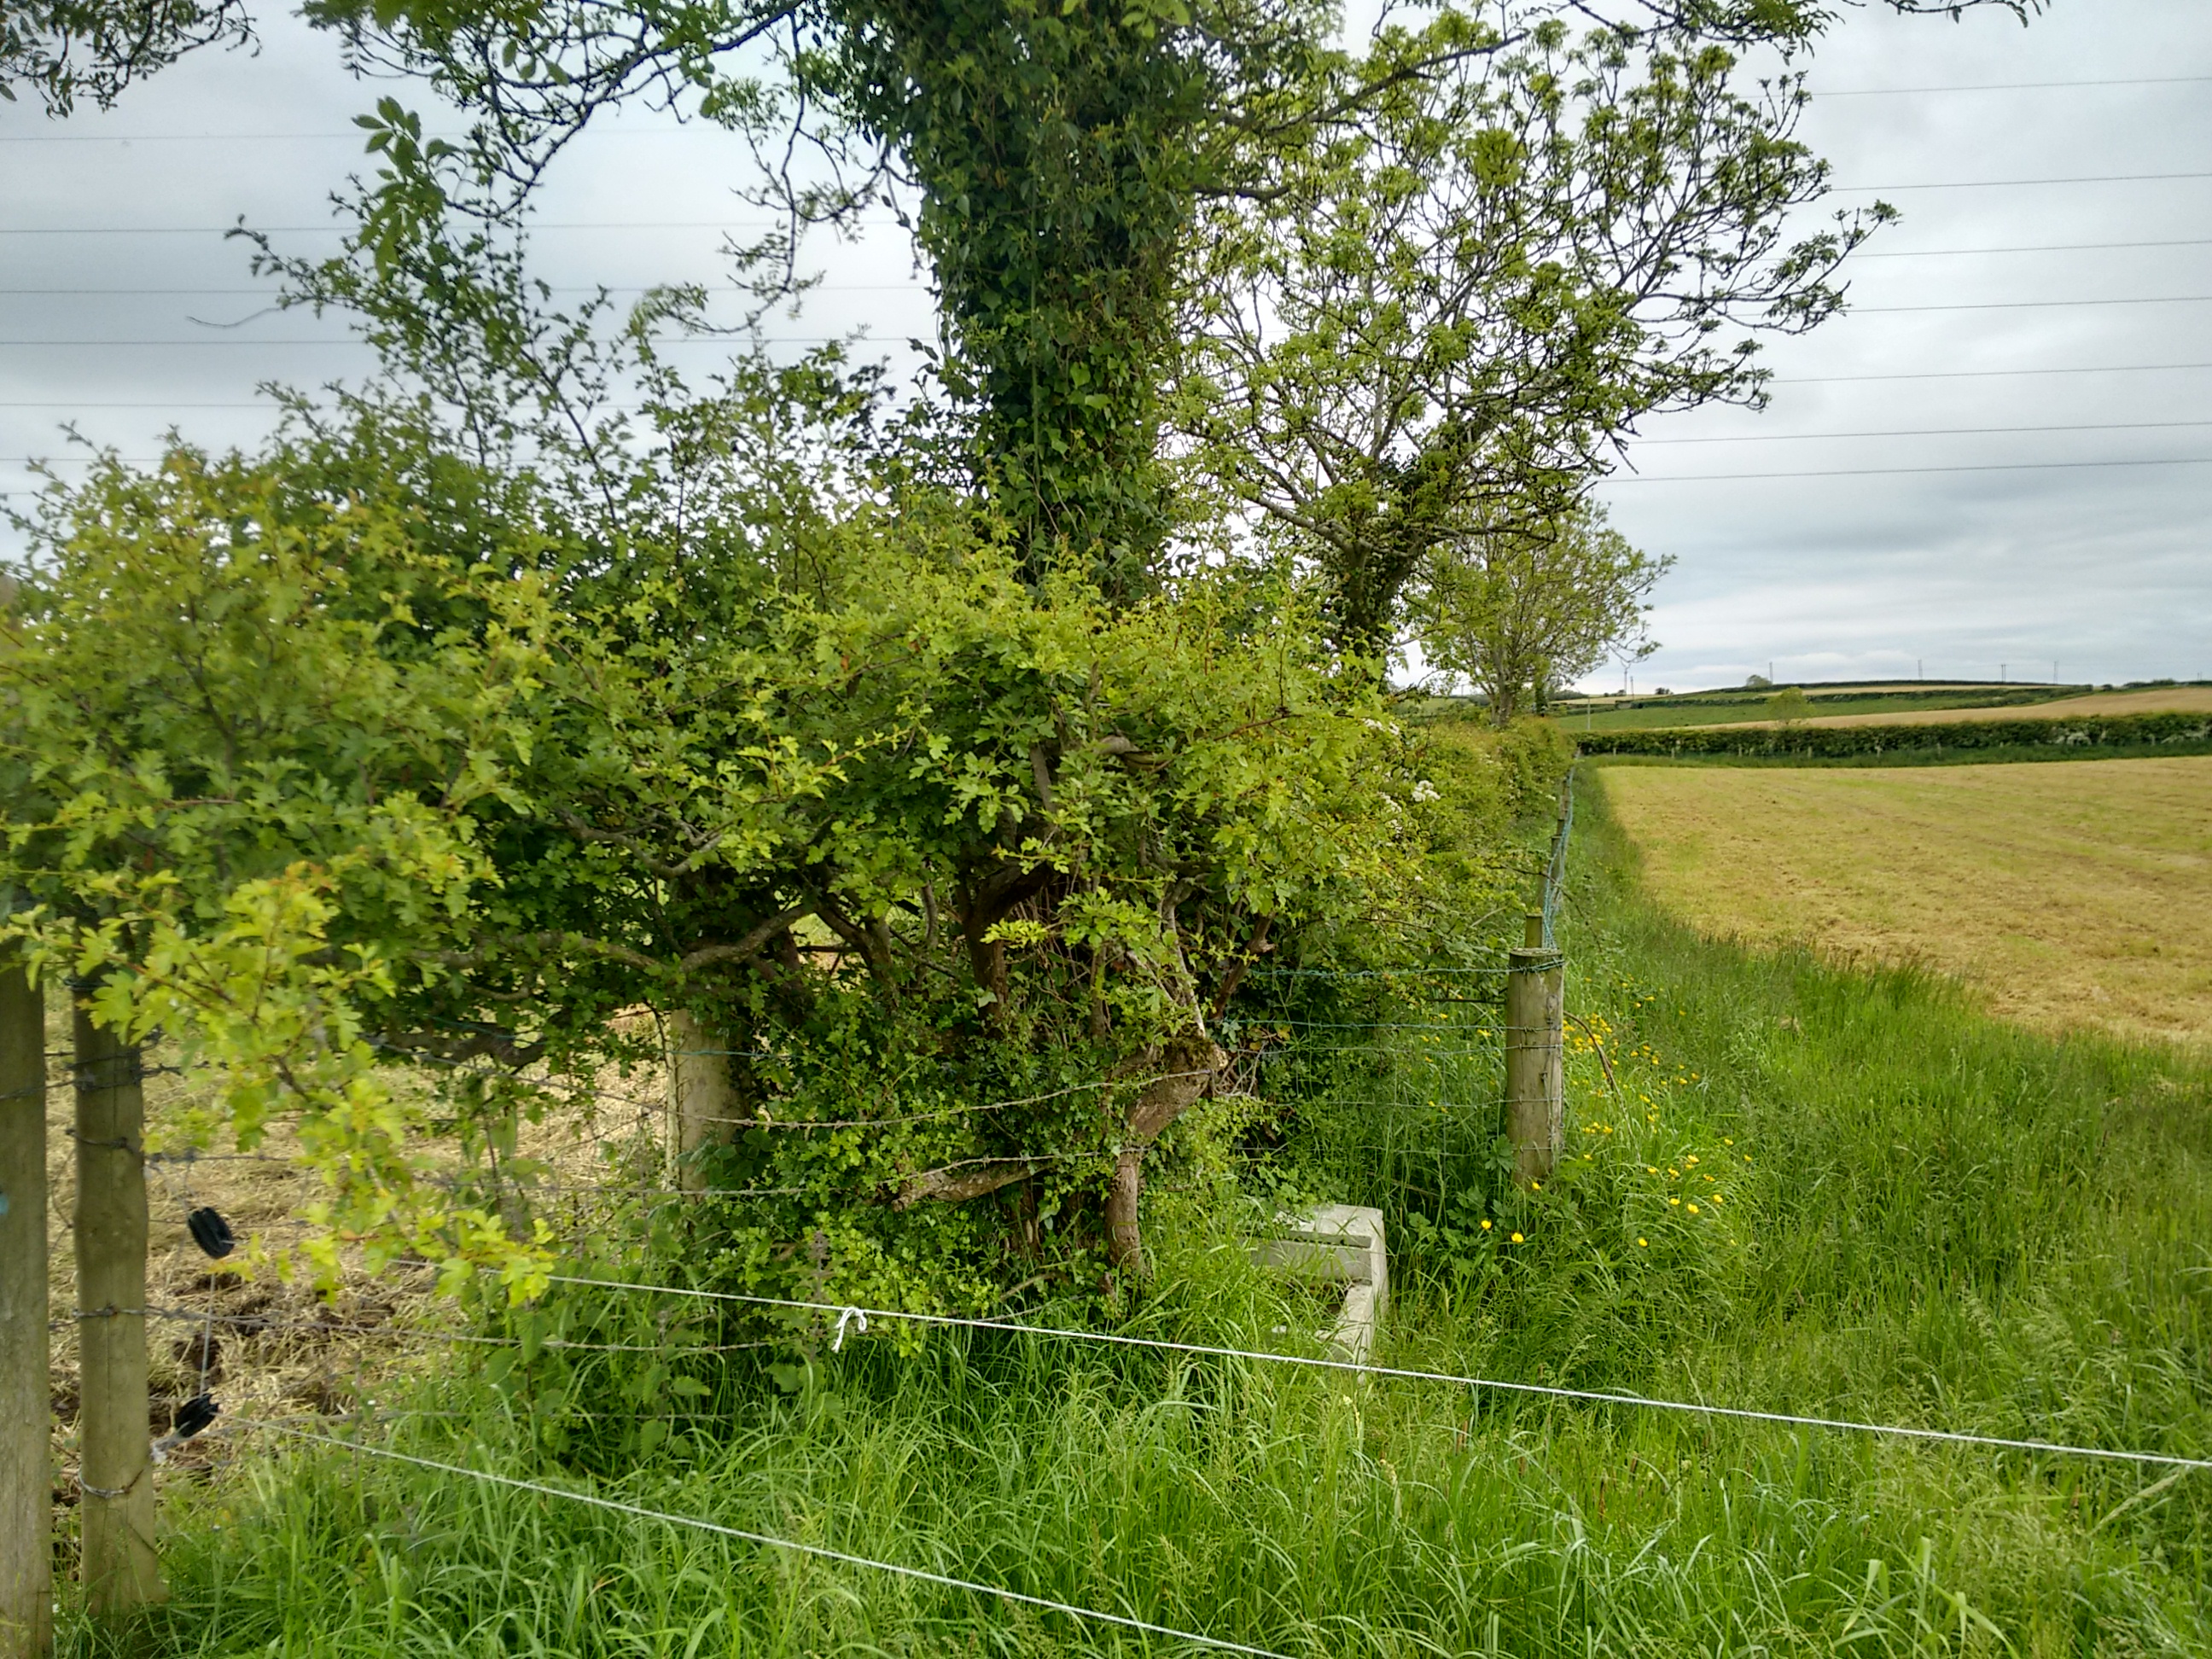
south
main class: Grassland
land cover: Grassland without tree/shrub cover
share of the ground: > 75 %
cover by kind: herbaceous plants 100 %
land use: Agriculture (excluding fallow land and kitchen gardens)
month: June
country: GB
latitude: 55.1048
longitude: -6.6630
